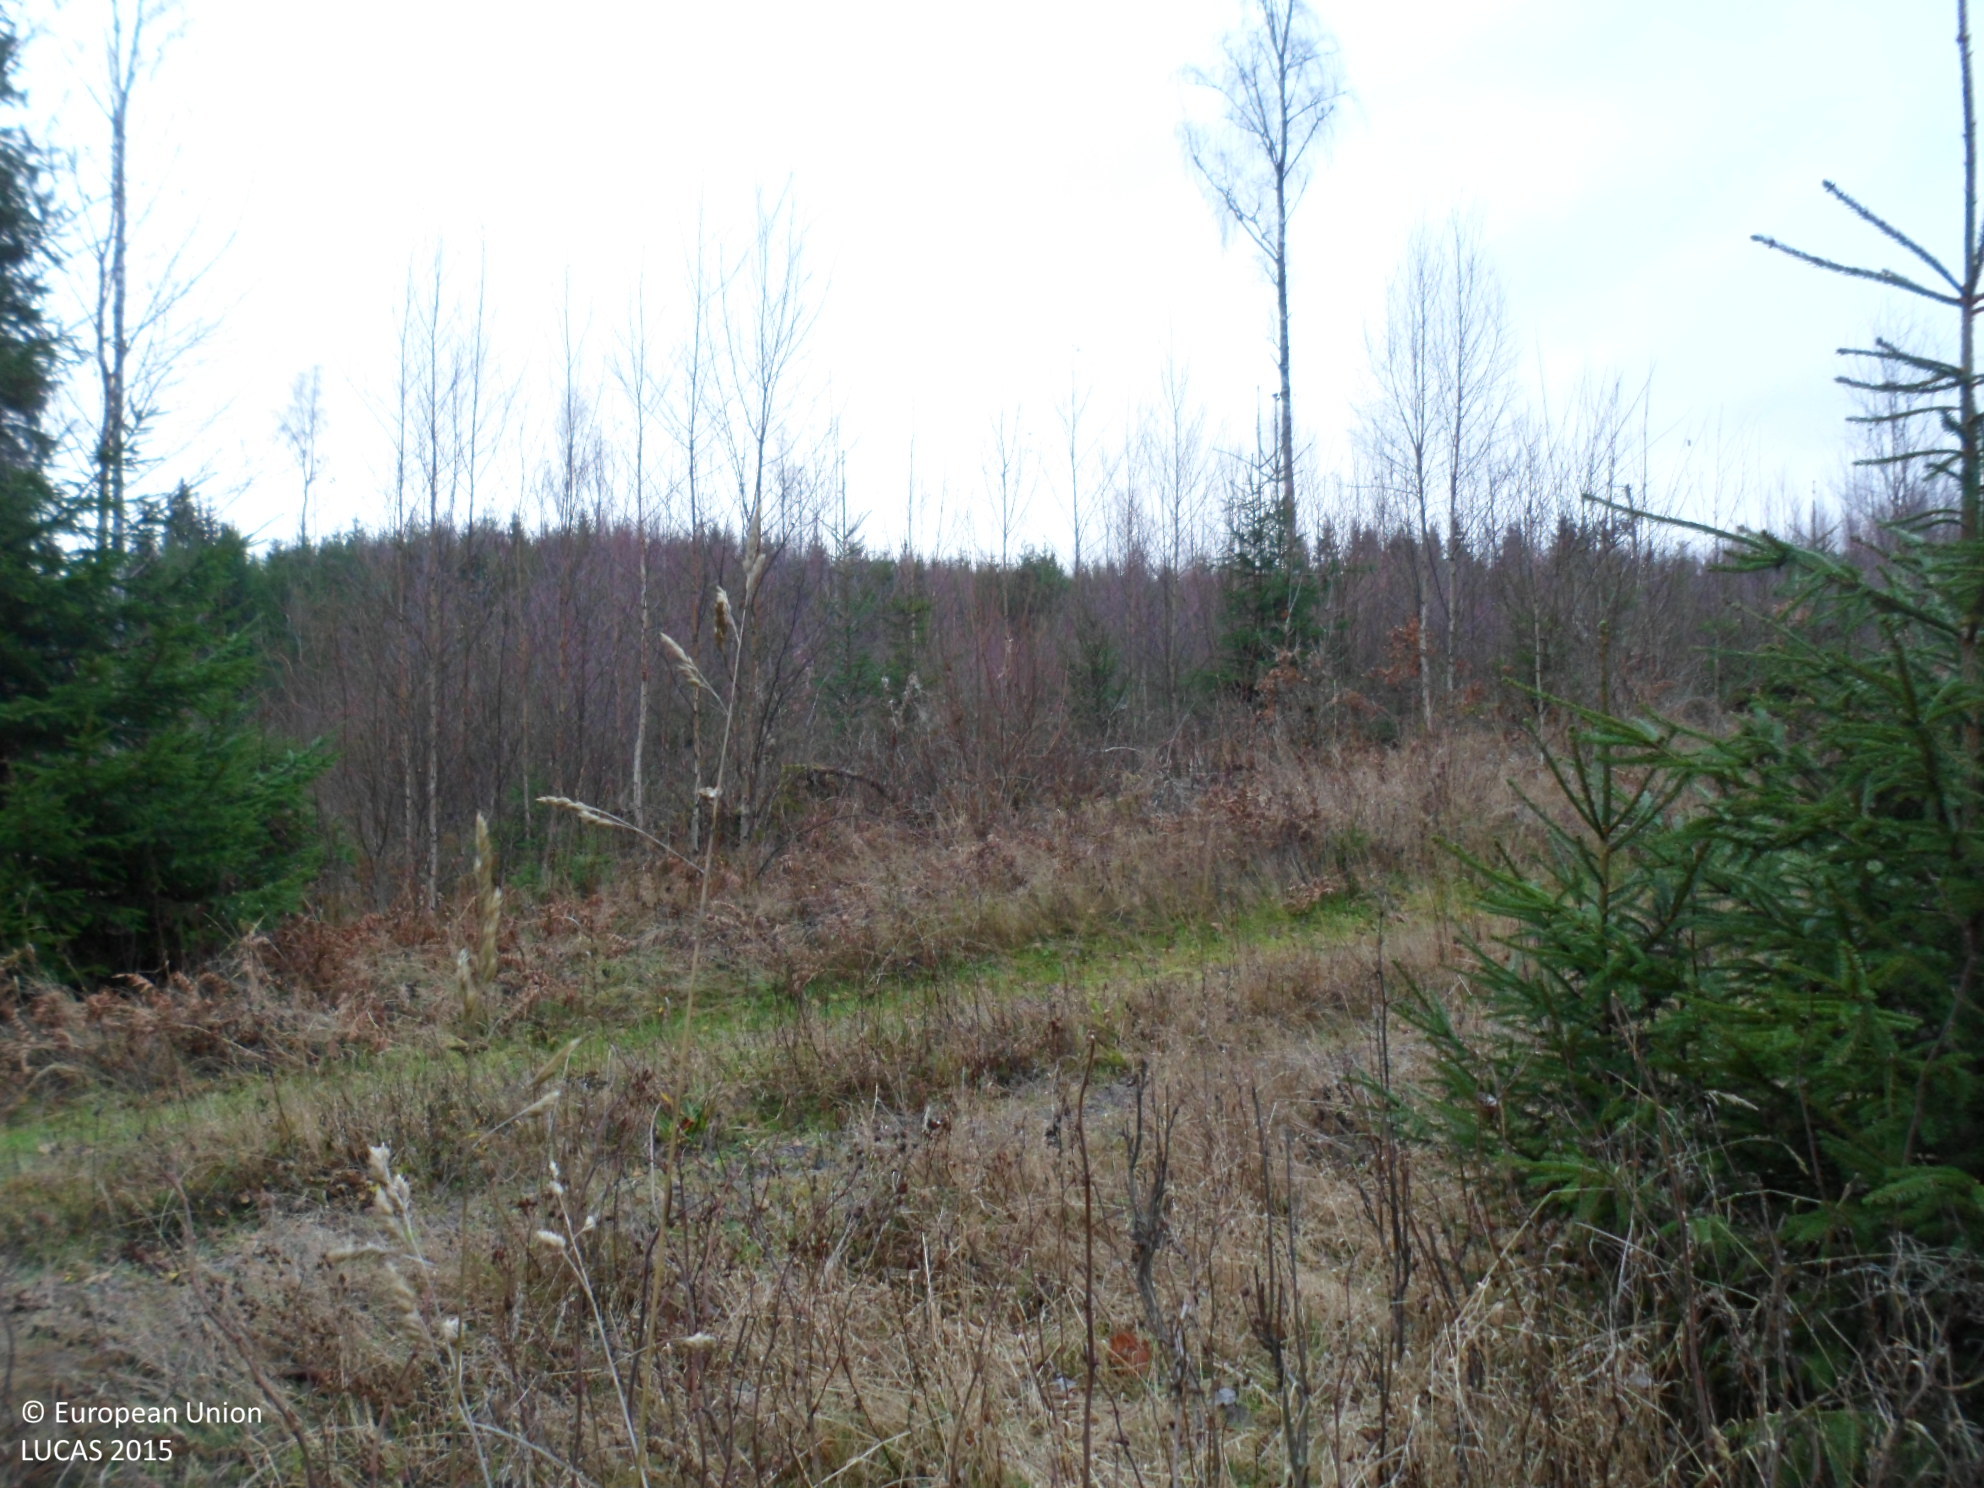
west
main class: Woodland
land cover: Spruce dominated mixed woodland
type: boreal forest
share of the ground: 25 - 50 %
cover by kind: shrubs 30 %, herbaceous plants 30 %, broadleaved forest trees 25 %, coniferous forest trees 10 %, lichens and mosses 5 %
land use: Forestry
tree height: < 5 m
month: November
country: SE
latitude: 57.1486
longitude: 15.5679
